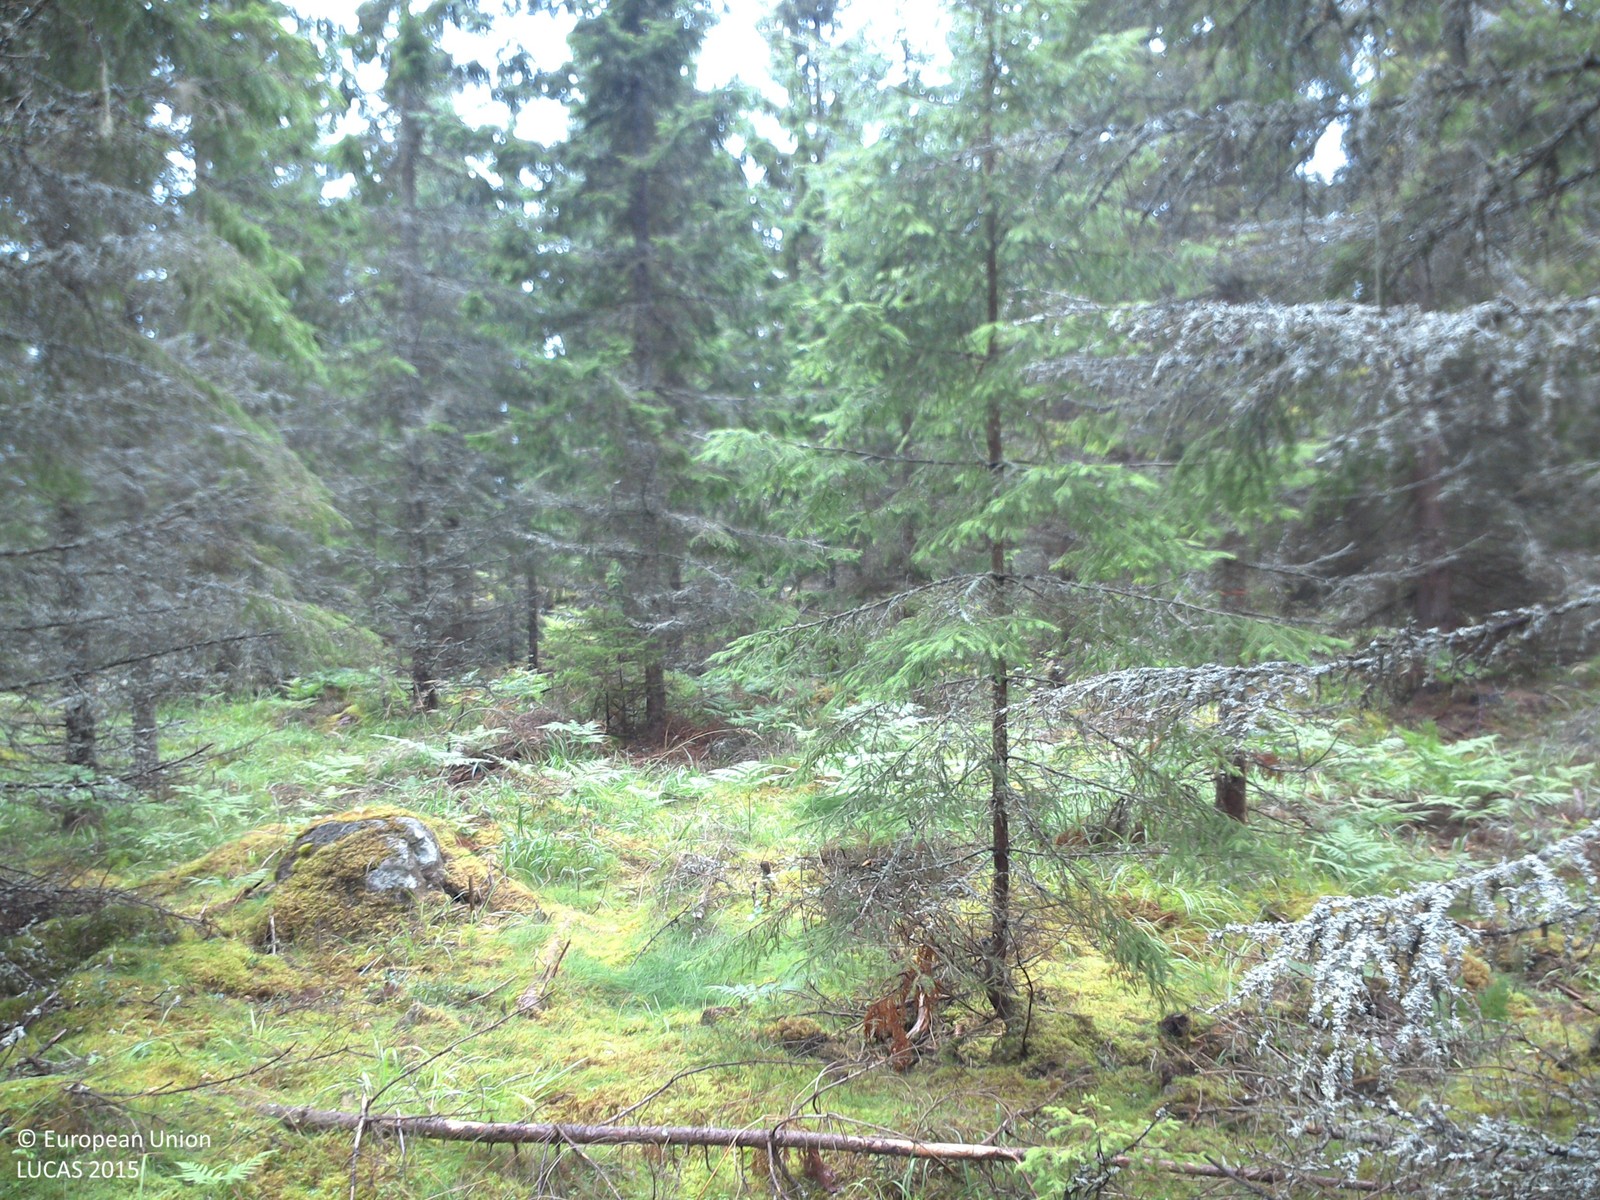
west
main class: Woodland
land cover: Spruce dominated coniferous woodland
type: boreal forest
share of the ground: 50 - 75 %
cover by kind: coniferous forest trees 55 %, lichens and mosses 30 %, herbaceous plants 15 %
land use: Forestry
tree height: > 5 m
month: August
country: SE
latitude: 58.2003
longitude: 15.4225
